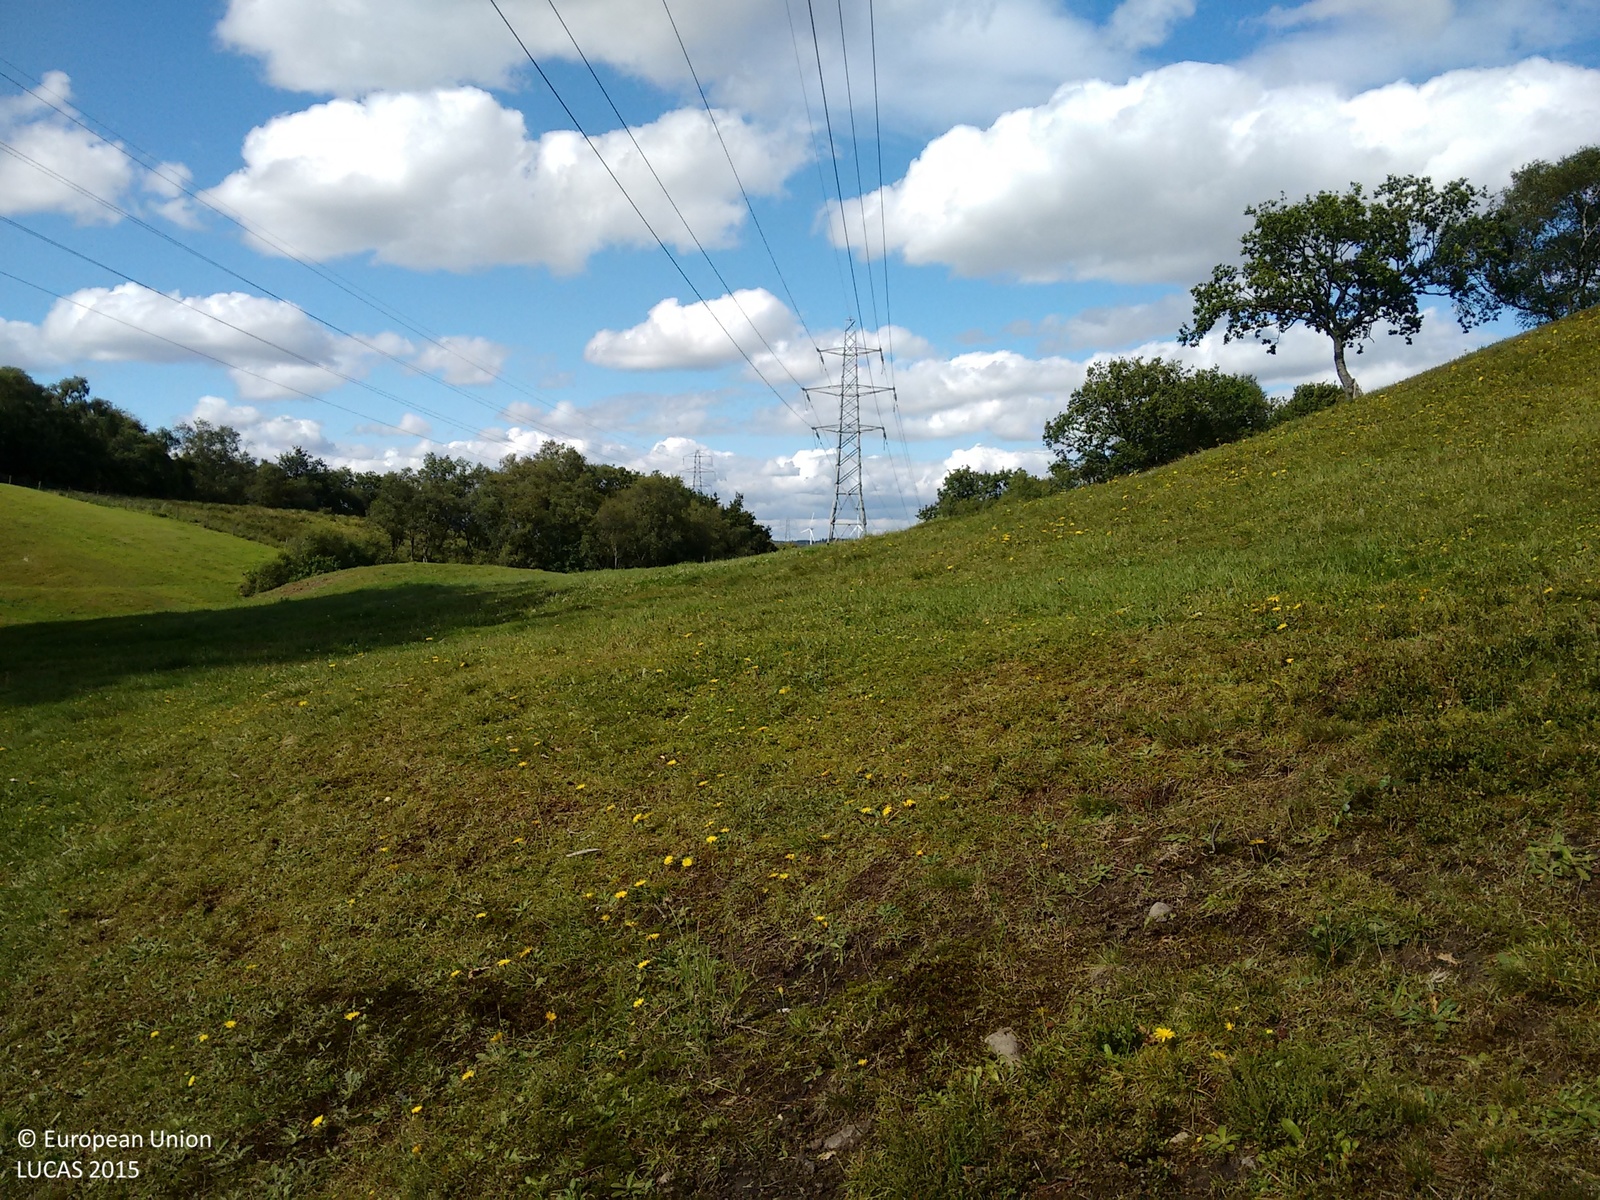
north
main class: Woodland
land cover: Broadleaved woodland
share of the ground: > 75 %
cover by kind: herbaceous plants 80 %, broadleaved forest trees 15 %, unconsolidated bare surface 5 %
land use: Amenities, museums, leisure
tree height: > 5 m
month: August
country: GB
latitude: 55.9974
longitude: -3.8572
